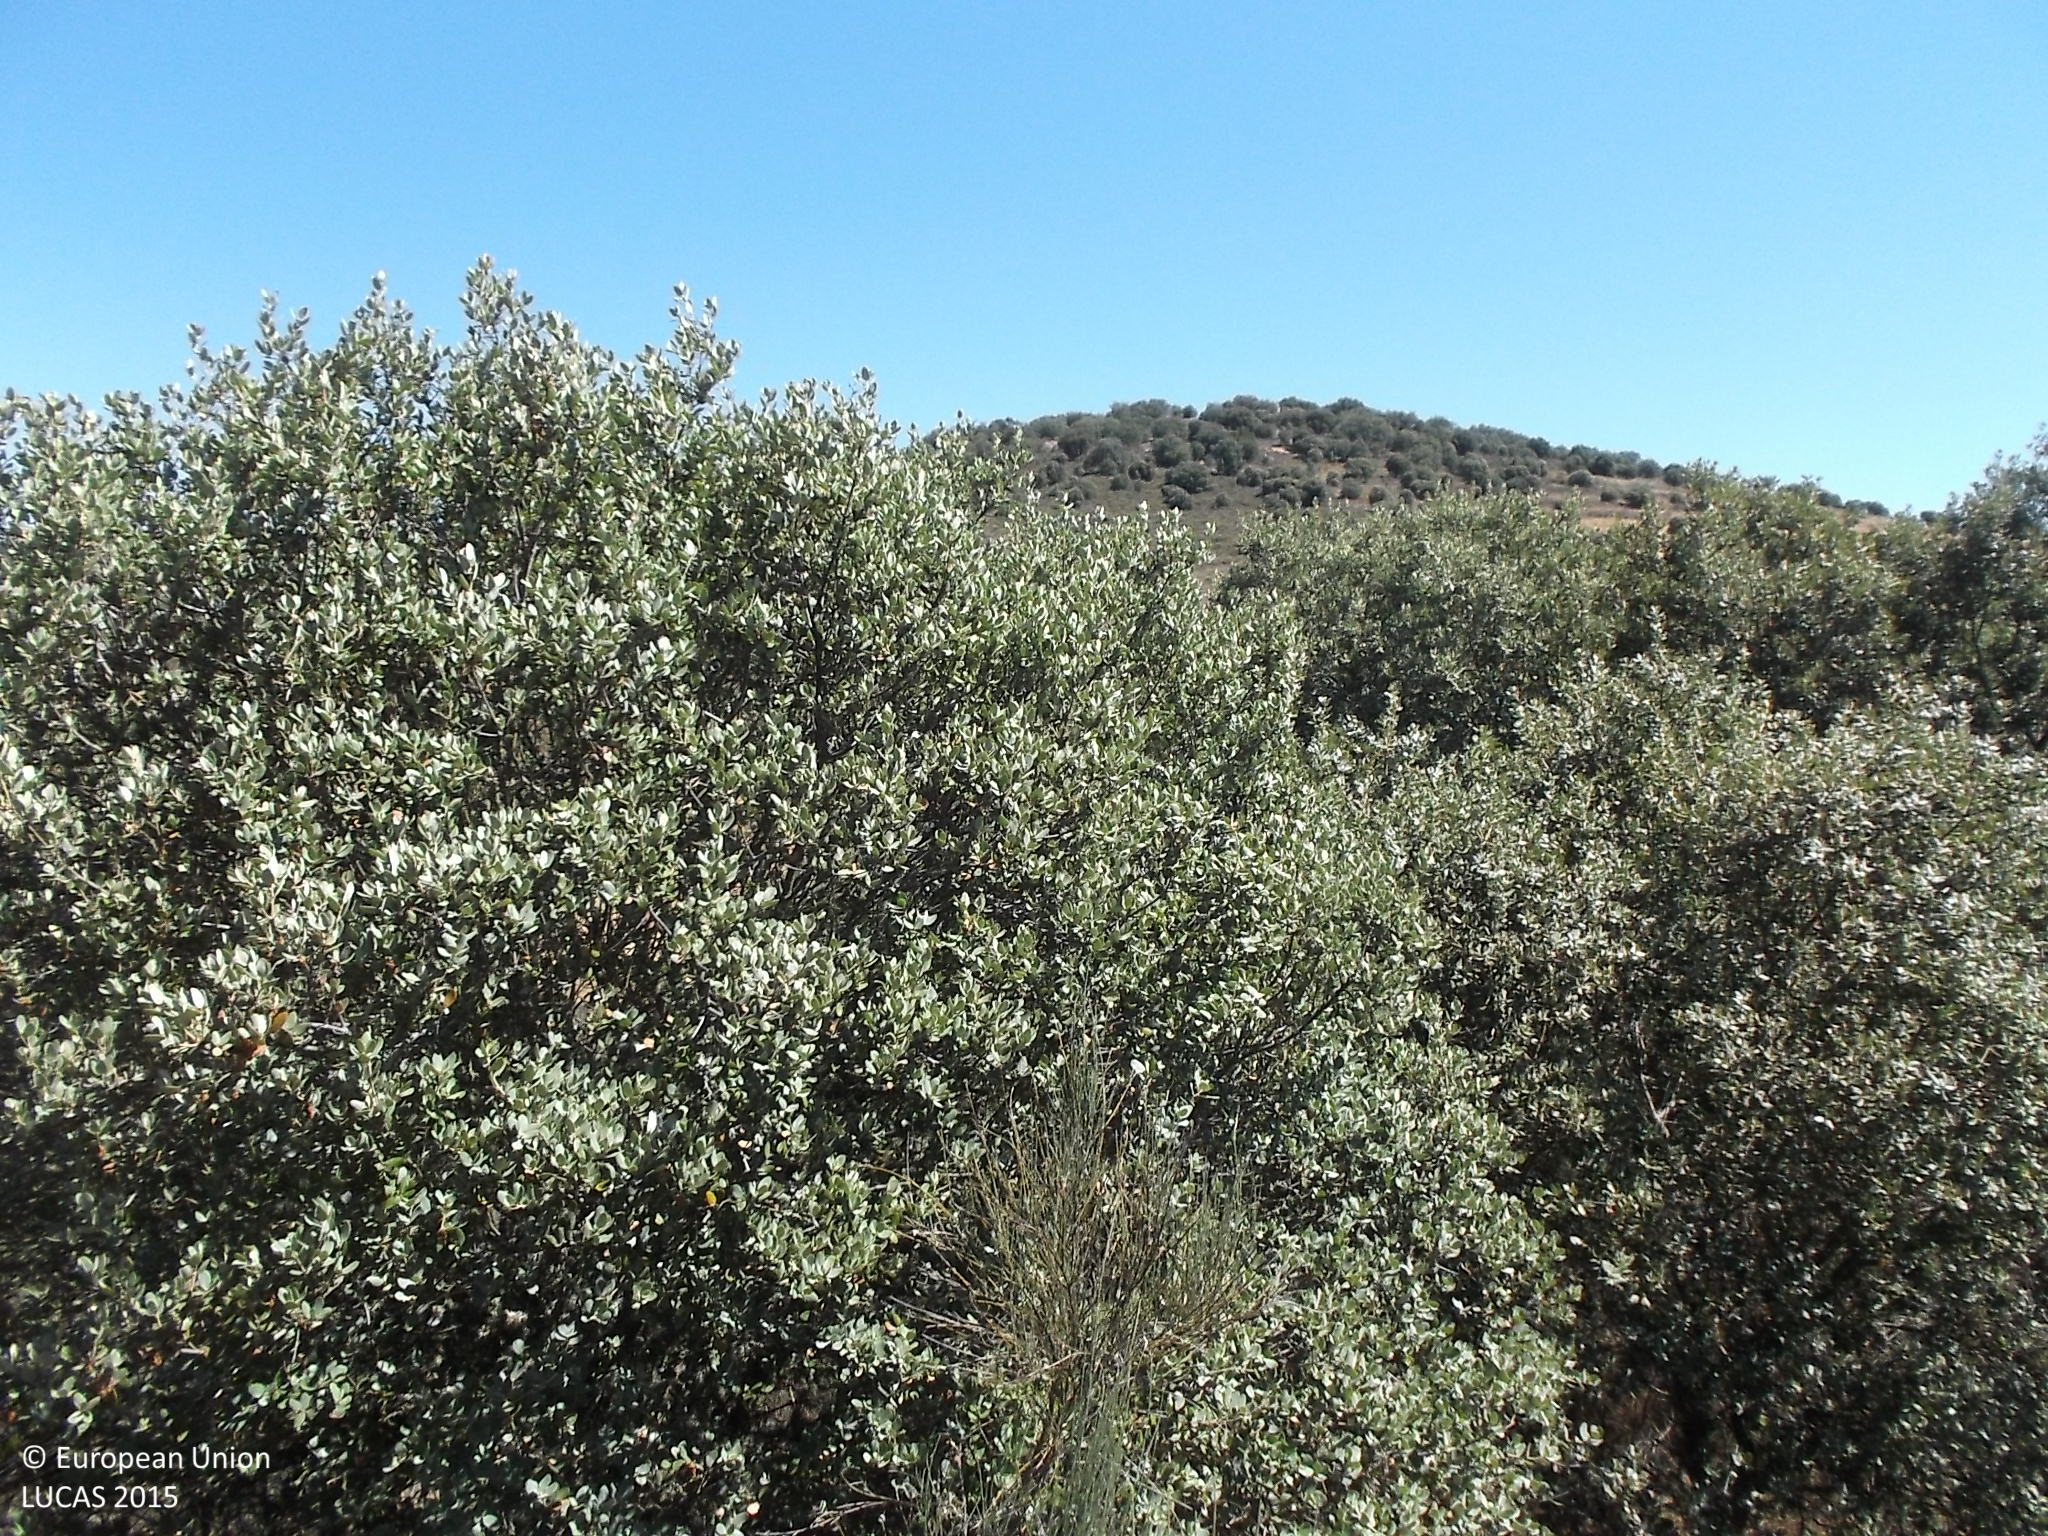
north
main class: Shrubland
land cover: Shrubland with sparse tree cover
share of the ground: > 75 %
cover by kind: shrubs 90 %, broadleaved forest trees 5 %, herbaceous plants 5 %
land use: Abandoned areas
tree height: < 5 m
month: June
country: ES
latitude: 40.8756
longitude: -6.7715
